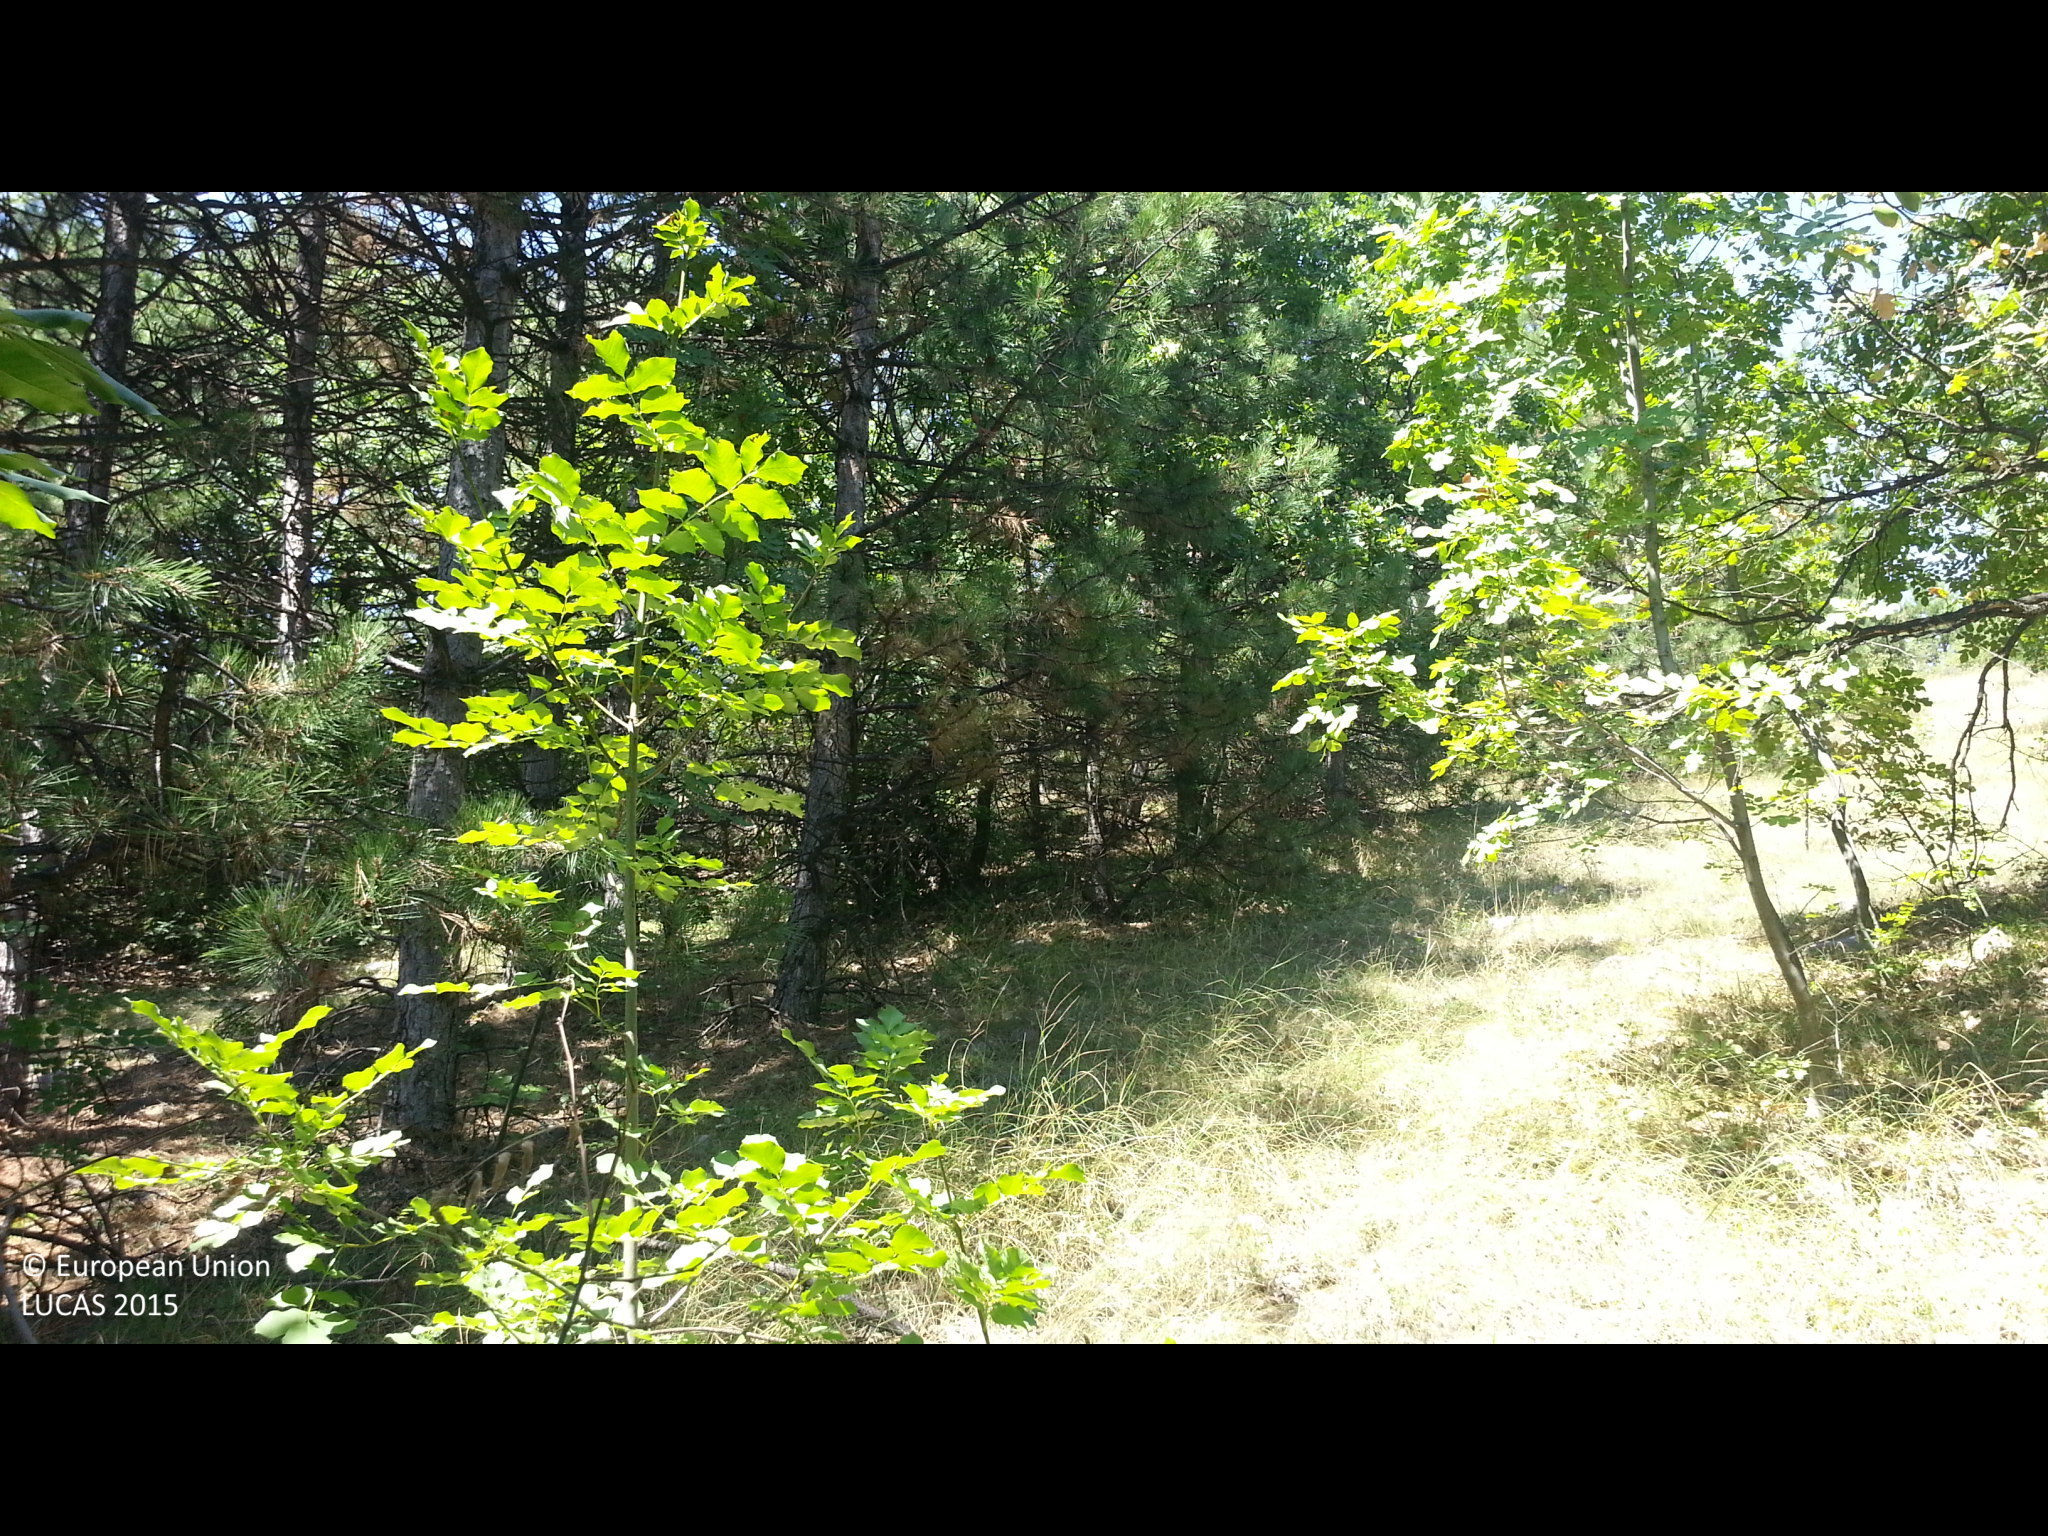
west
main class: Woodland
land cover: Pine dominated mixed woodland
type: hemiboreal forest and nemoral coniferous forest and mixed broadleaved-coniferous forest
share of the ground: > 75 %
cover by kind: coniferous forest trees 75 %, broadleaved forest trees 25 %
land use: Forestry
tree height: > 5 m
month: August
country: BG
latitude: 42.5278
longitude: 23.1167
